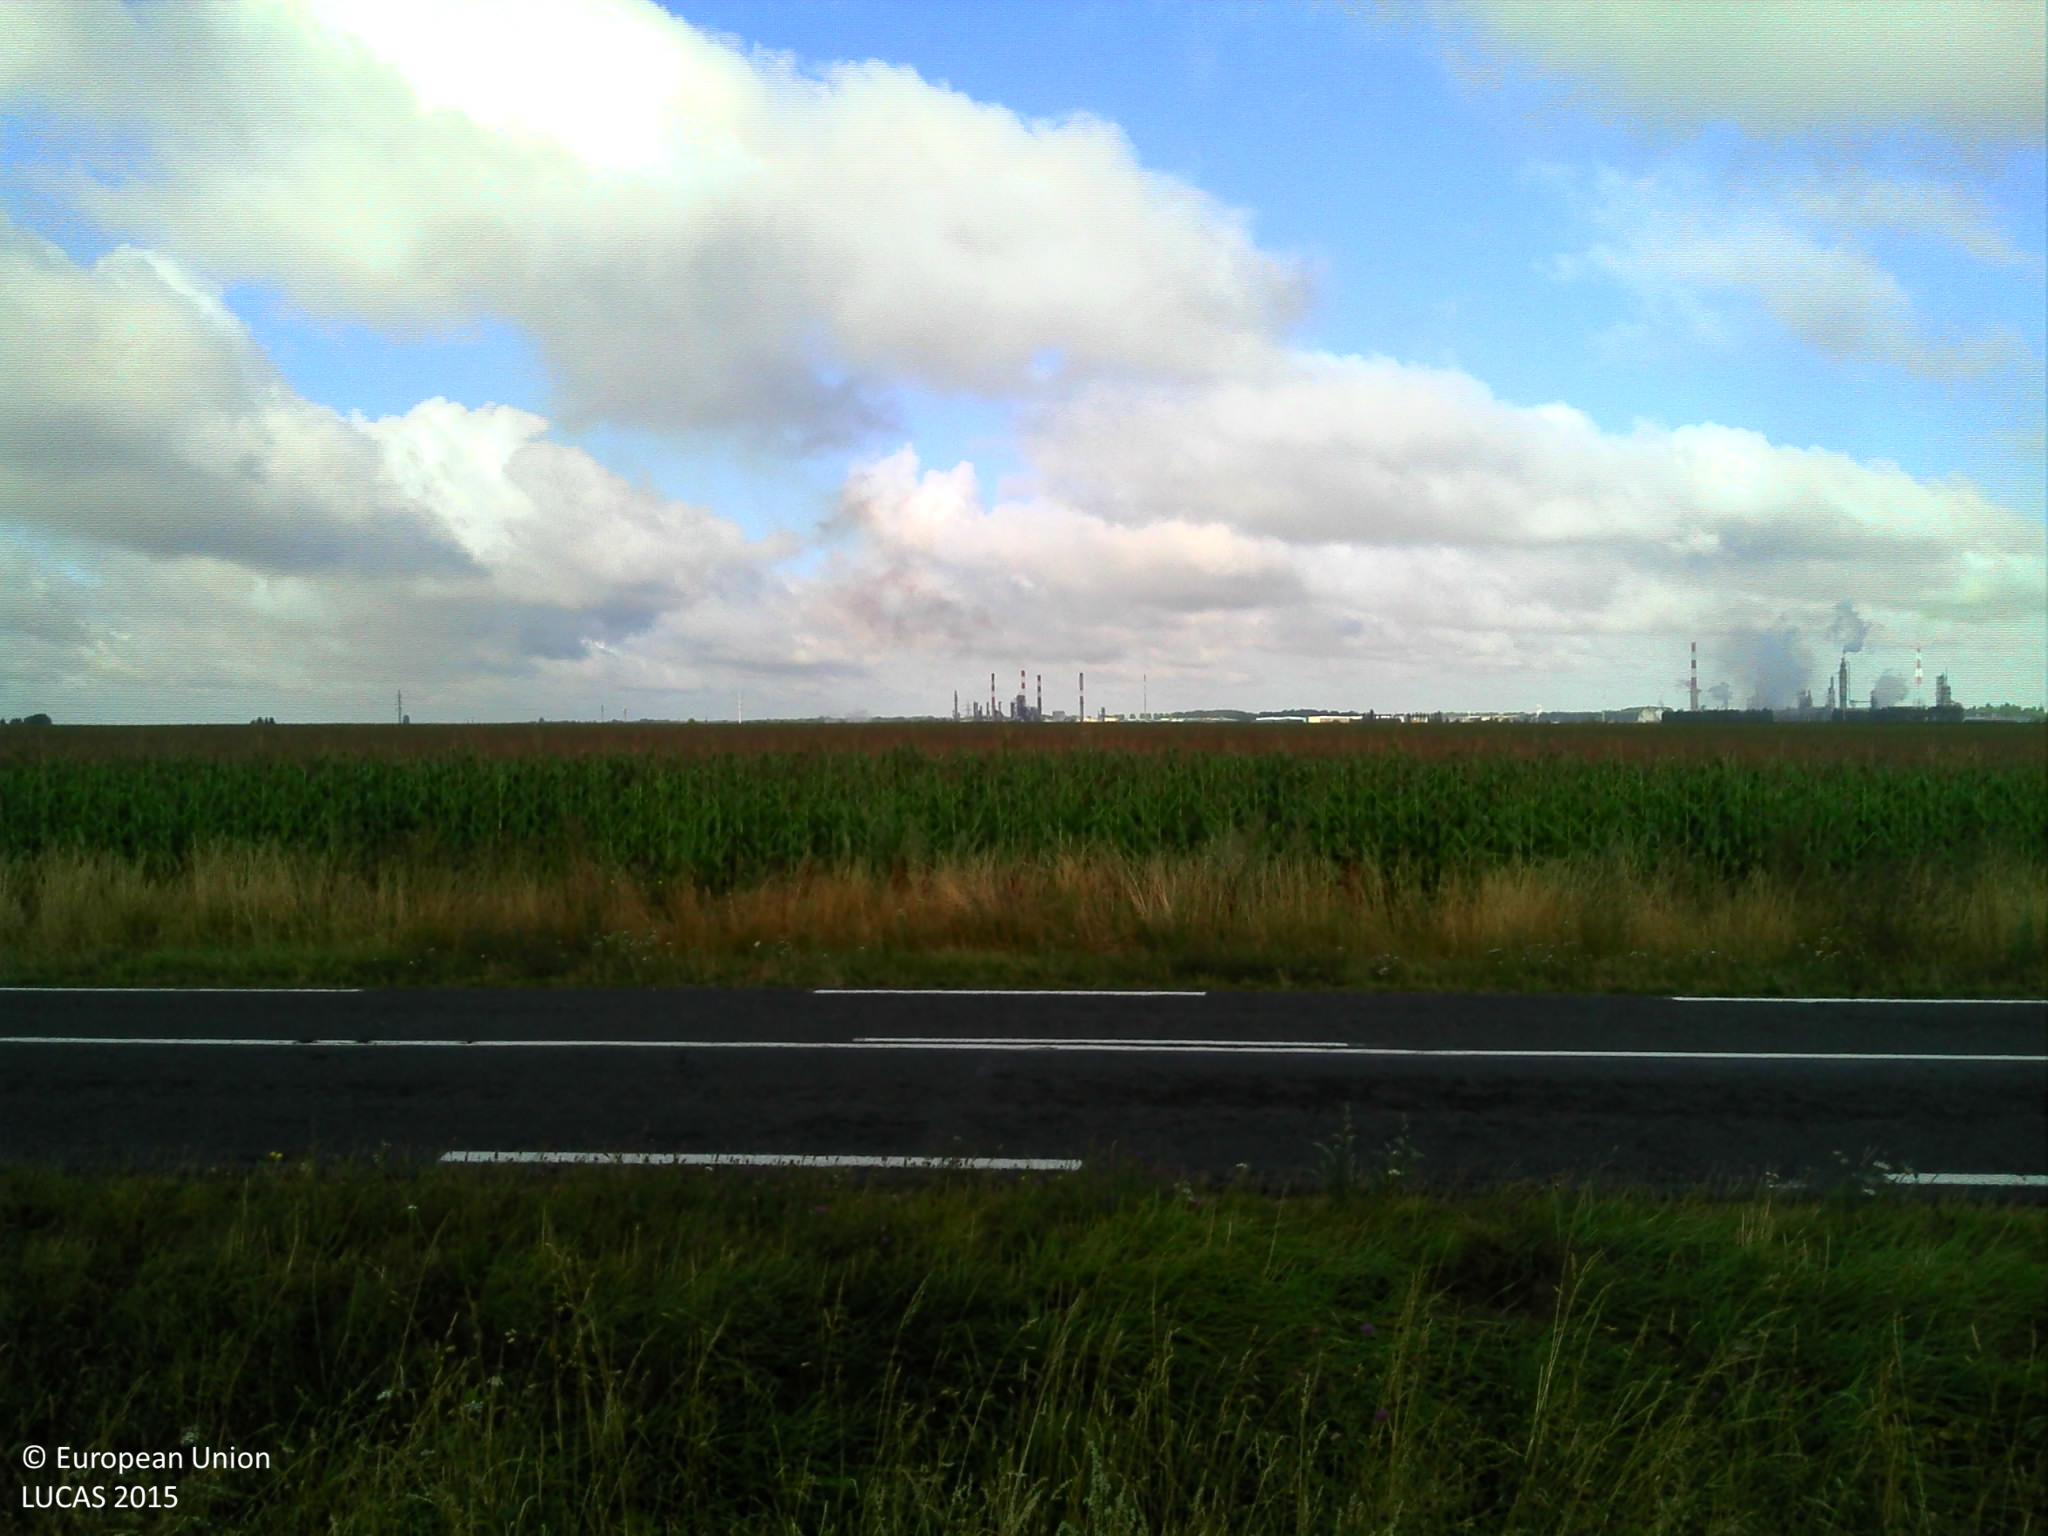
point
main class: Cropland
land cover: Maize
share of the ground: > 75 %
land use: Agriculture (excluding fallow land and kitchen gardens)
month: July
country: FR
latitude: 48.5957
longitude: 2.9815
